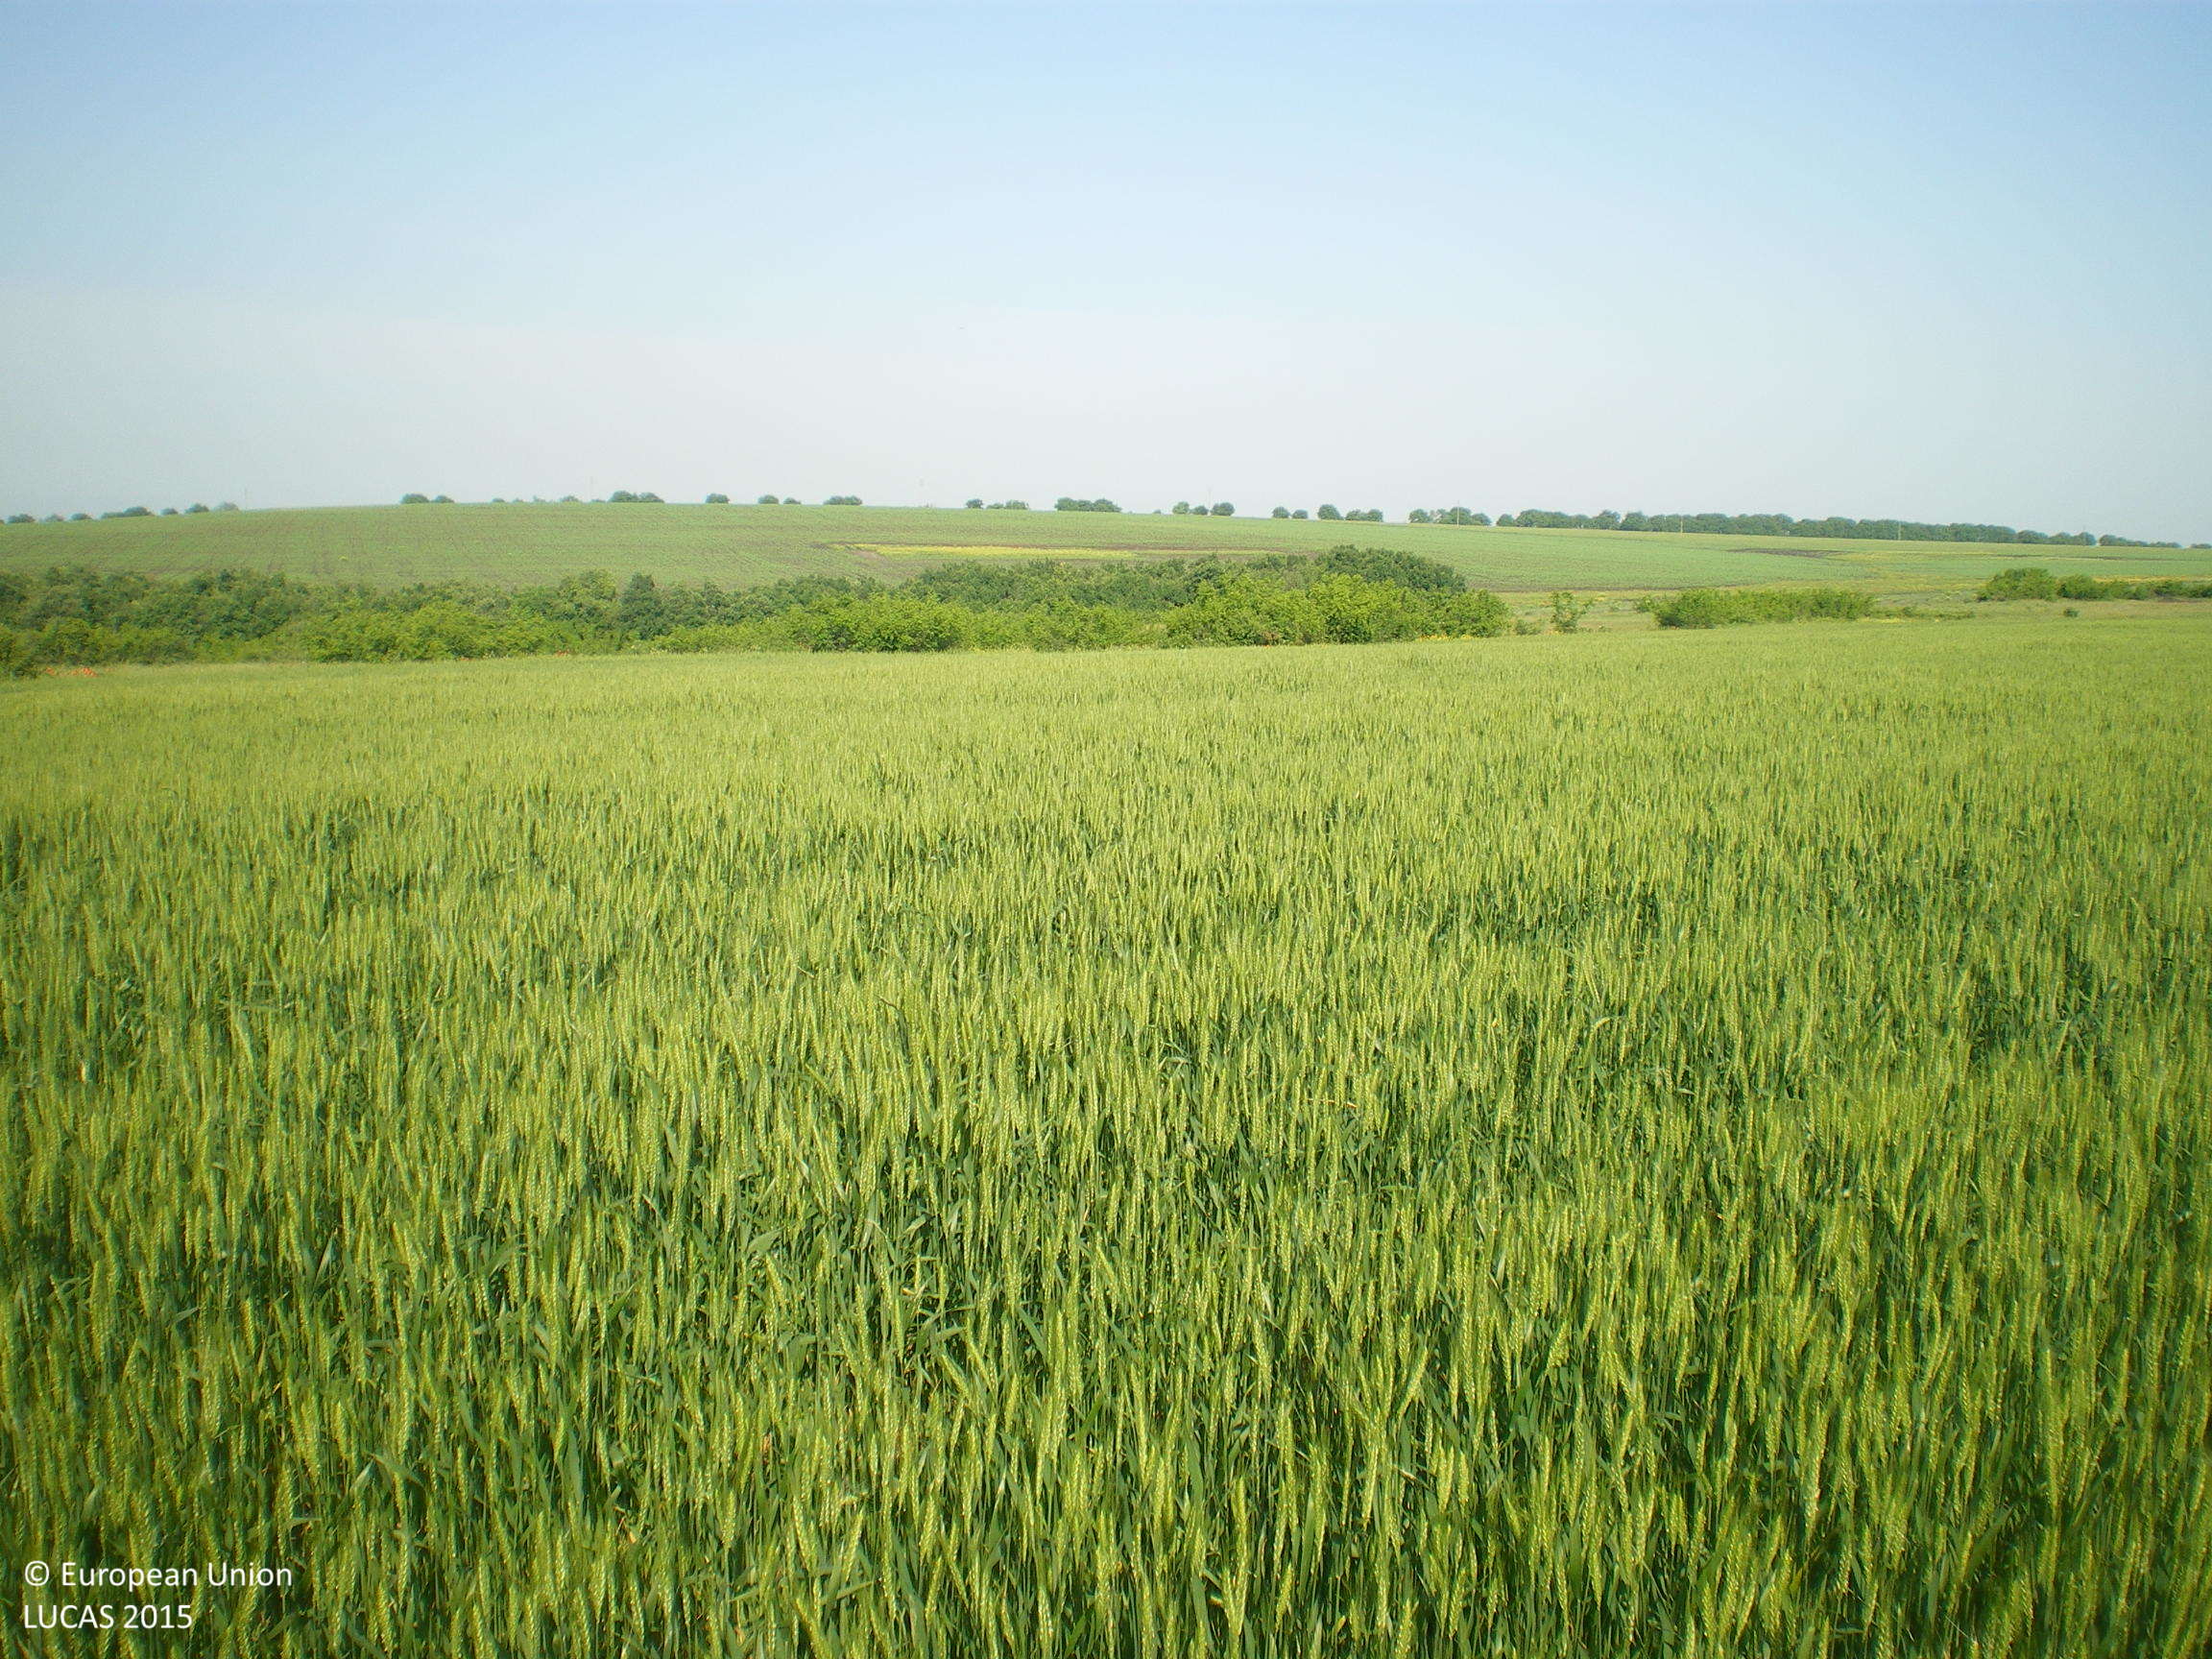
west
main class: Cropland
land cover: Barley
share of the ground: > 75 %
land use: Agriculture (excluding fallow land and kitchen gardens)
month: May
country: BG
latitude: 42.1441
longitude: 25.4192
